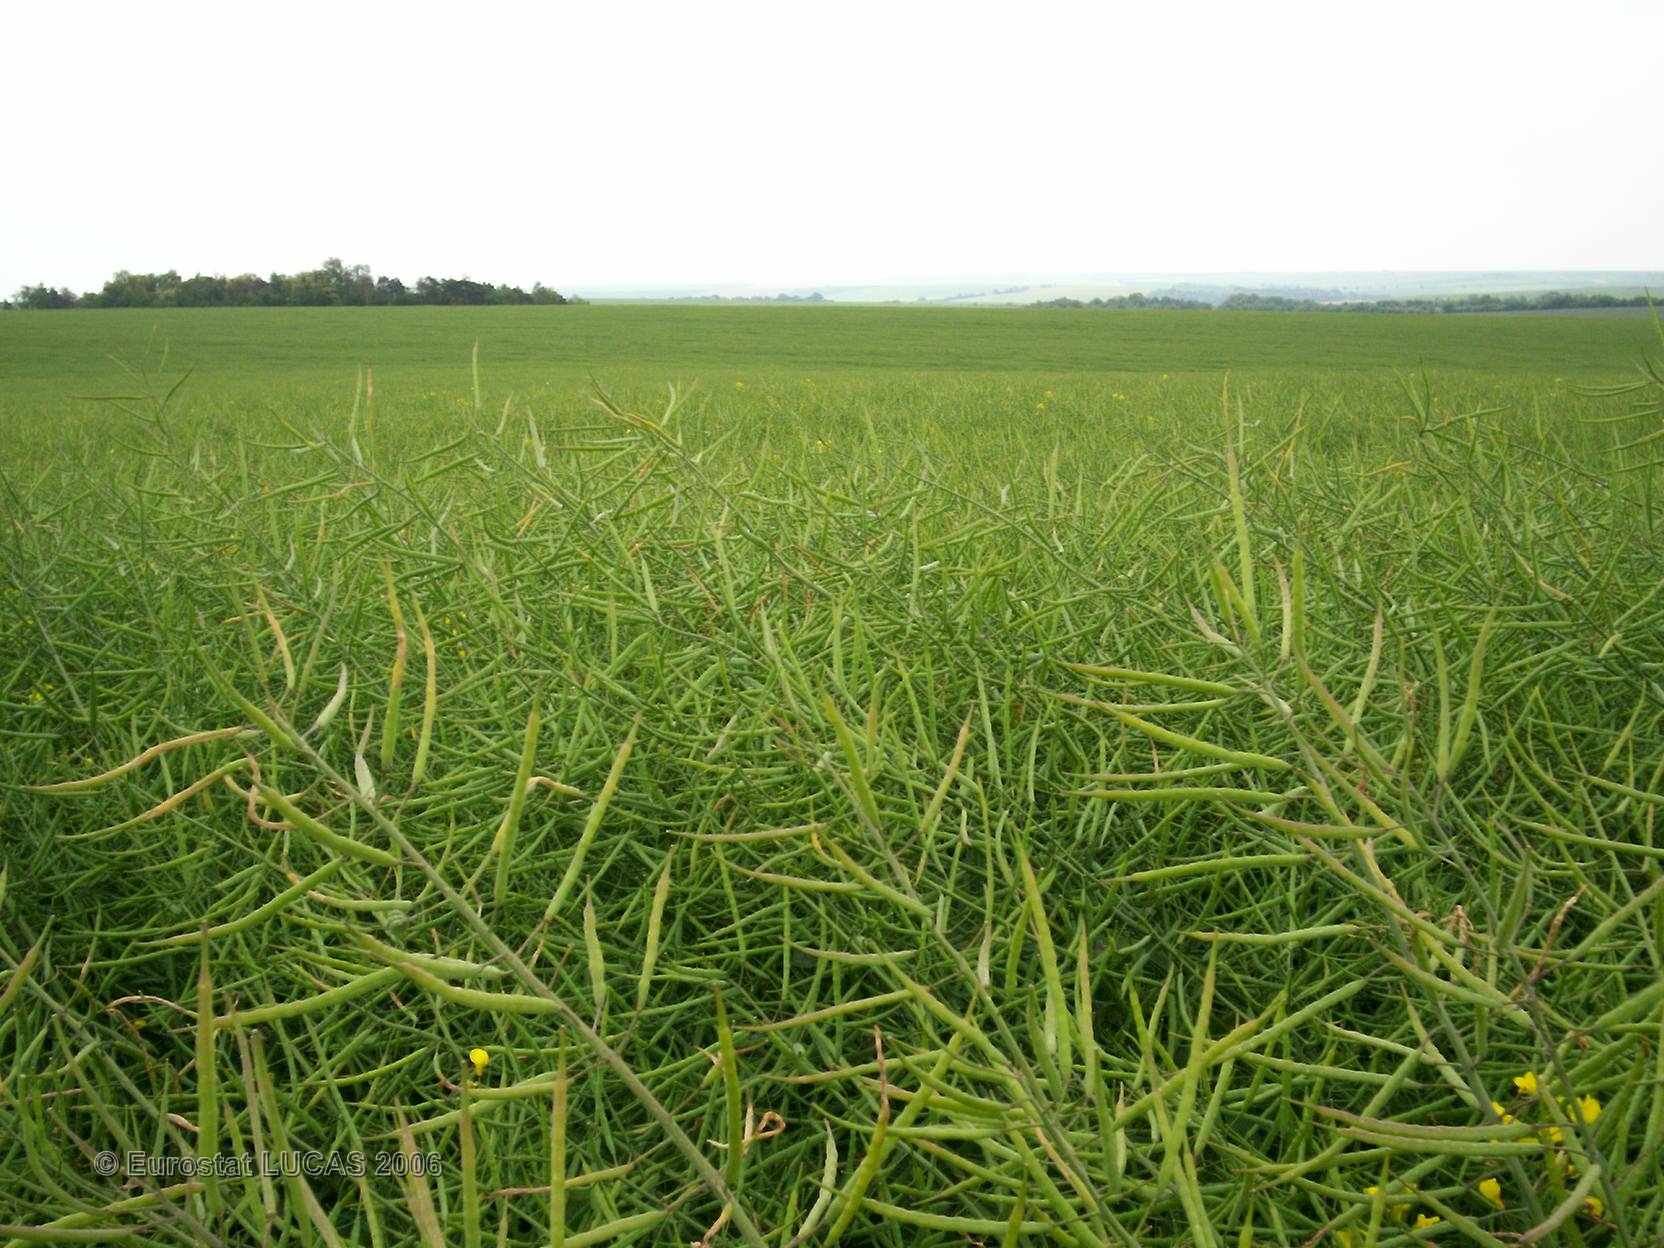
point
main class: Cropland
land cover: Rape and turnip rape
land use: Agriculture (excluding fallow land and kitchen gardens)
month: June
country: FR
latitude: 48.6951
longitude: 4.4129
